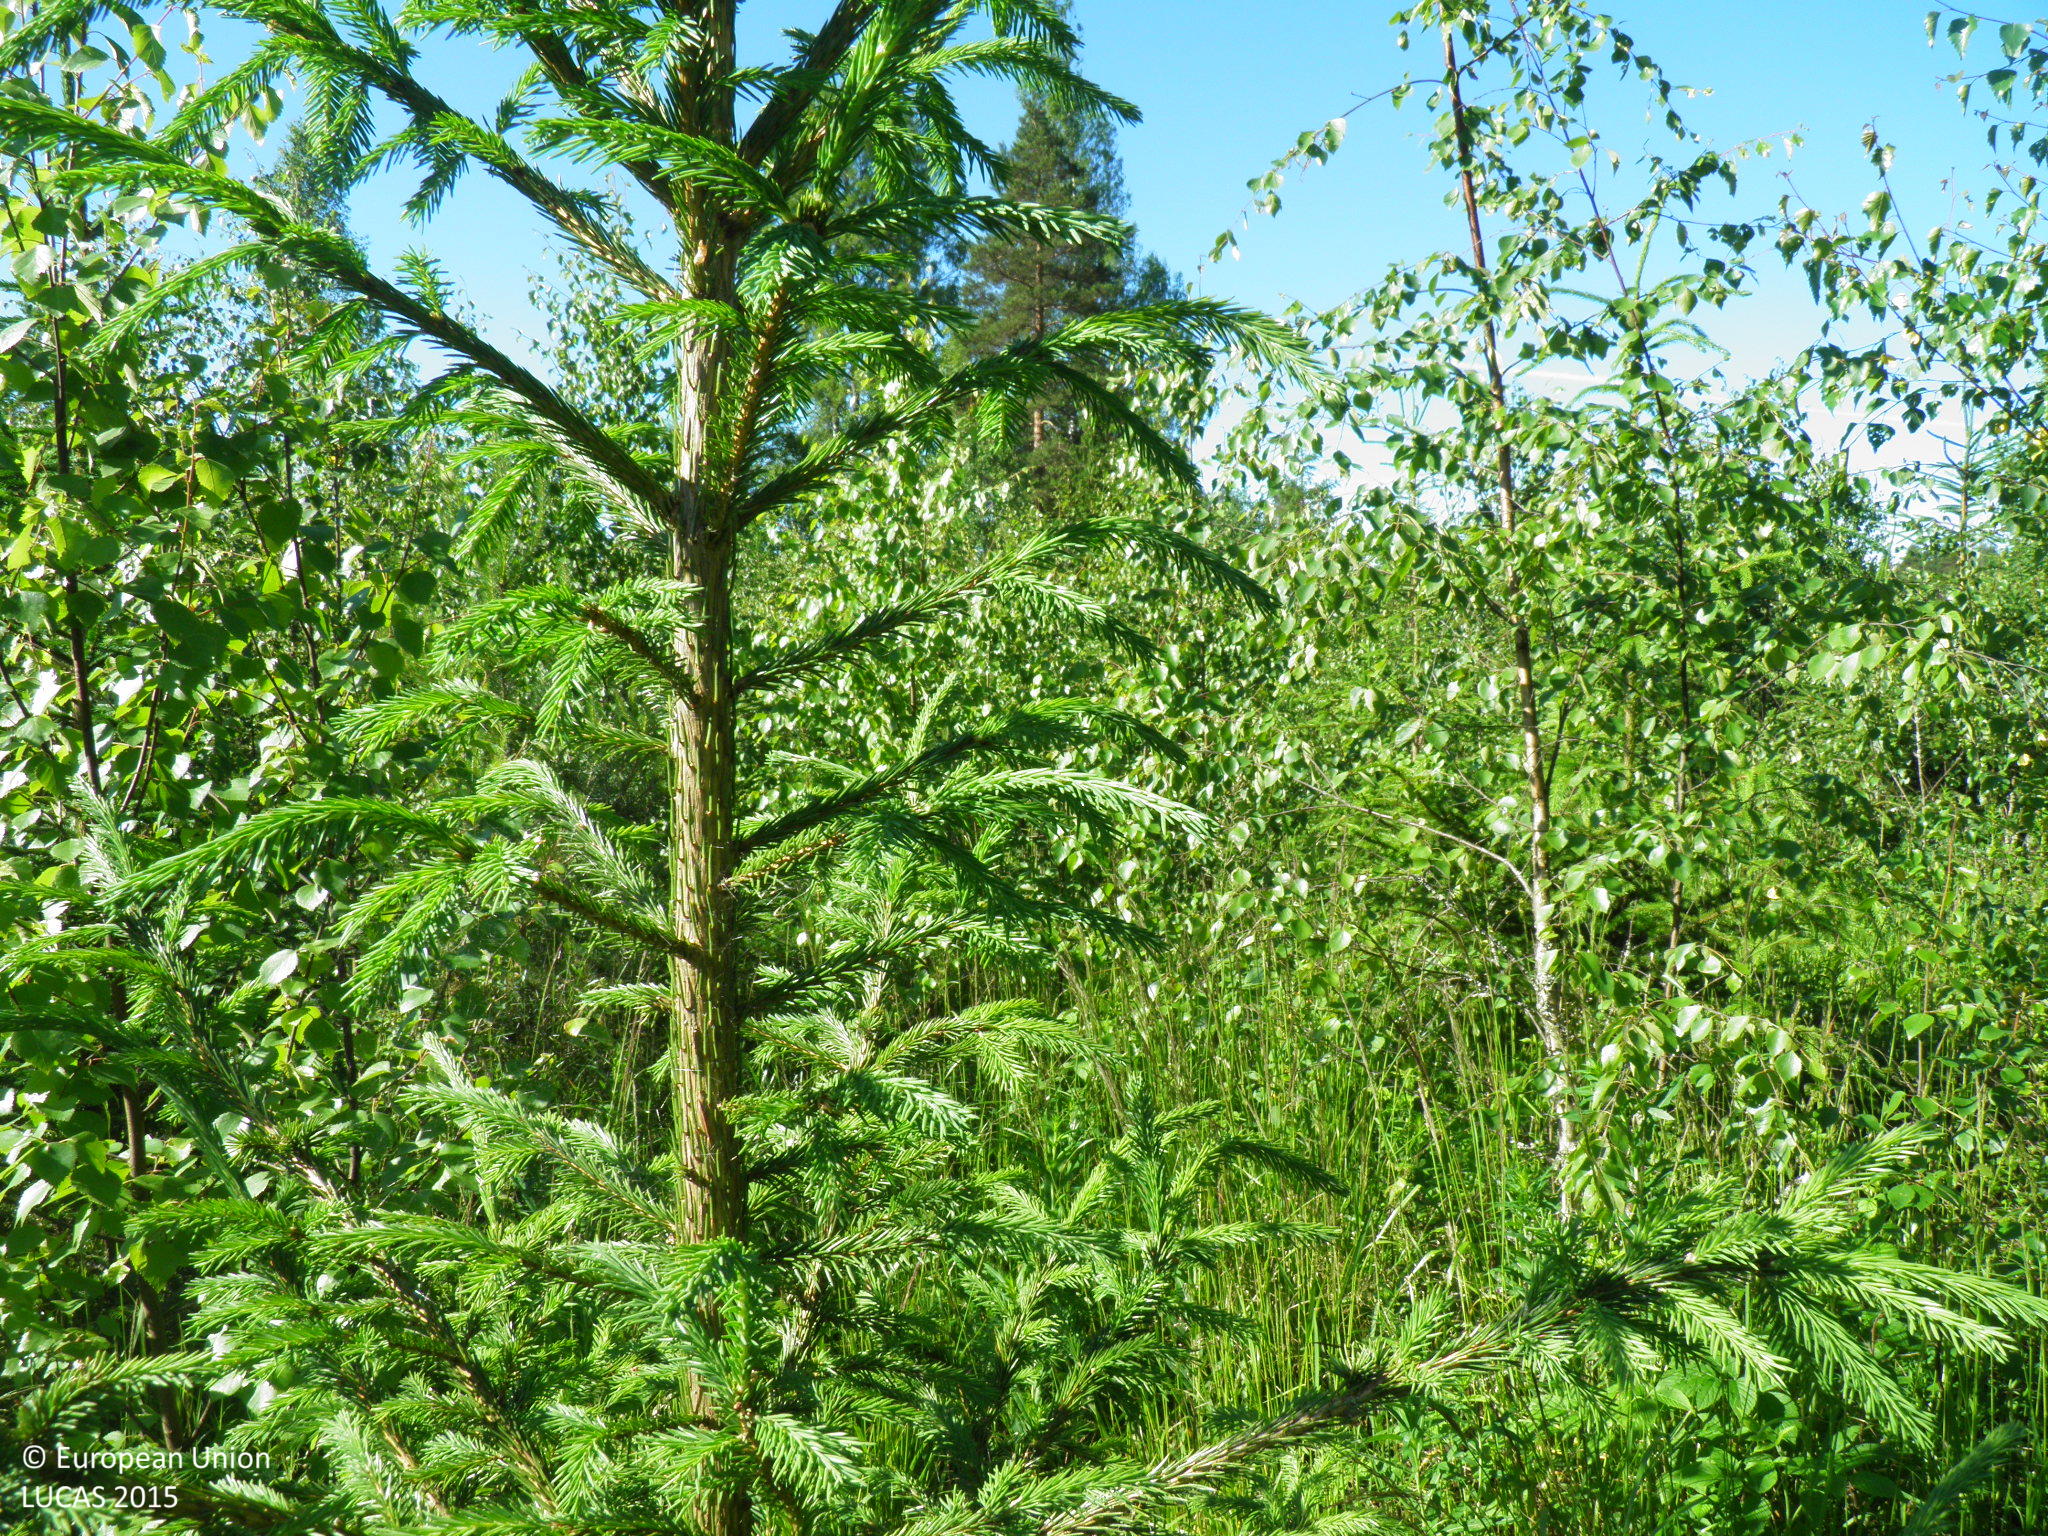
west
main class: Woodland
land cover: Other mixed woodland
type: hemiboreal forest and nemoral coniferous forest and mixed broadleaved-coniferous forest
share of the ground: 50 - 75 %
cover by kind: broadleaved forest trees 55 %, coniferous forest trees 20 %, herbaceous plants 15 %, shrubs 10 %
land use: Forestry
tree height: < 5 m
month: July
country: FI
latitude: 60.5256
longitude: 22.8105
